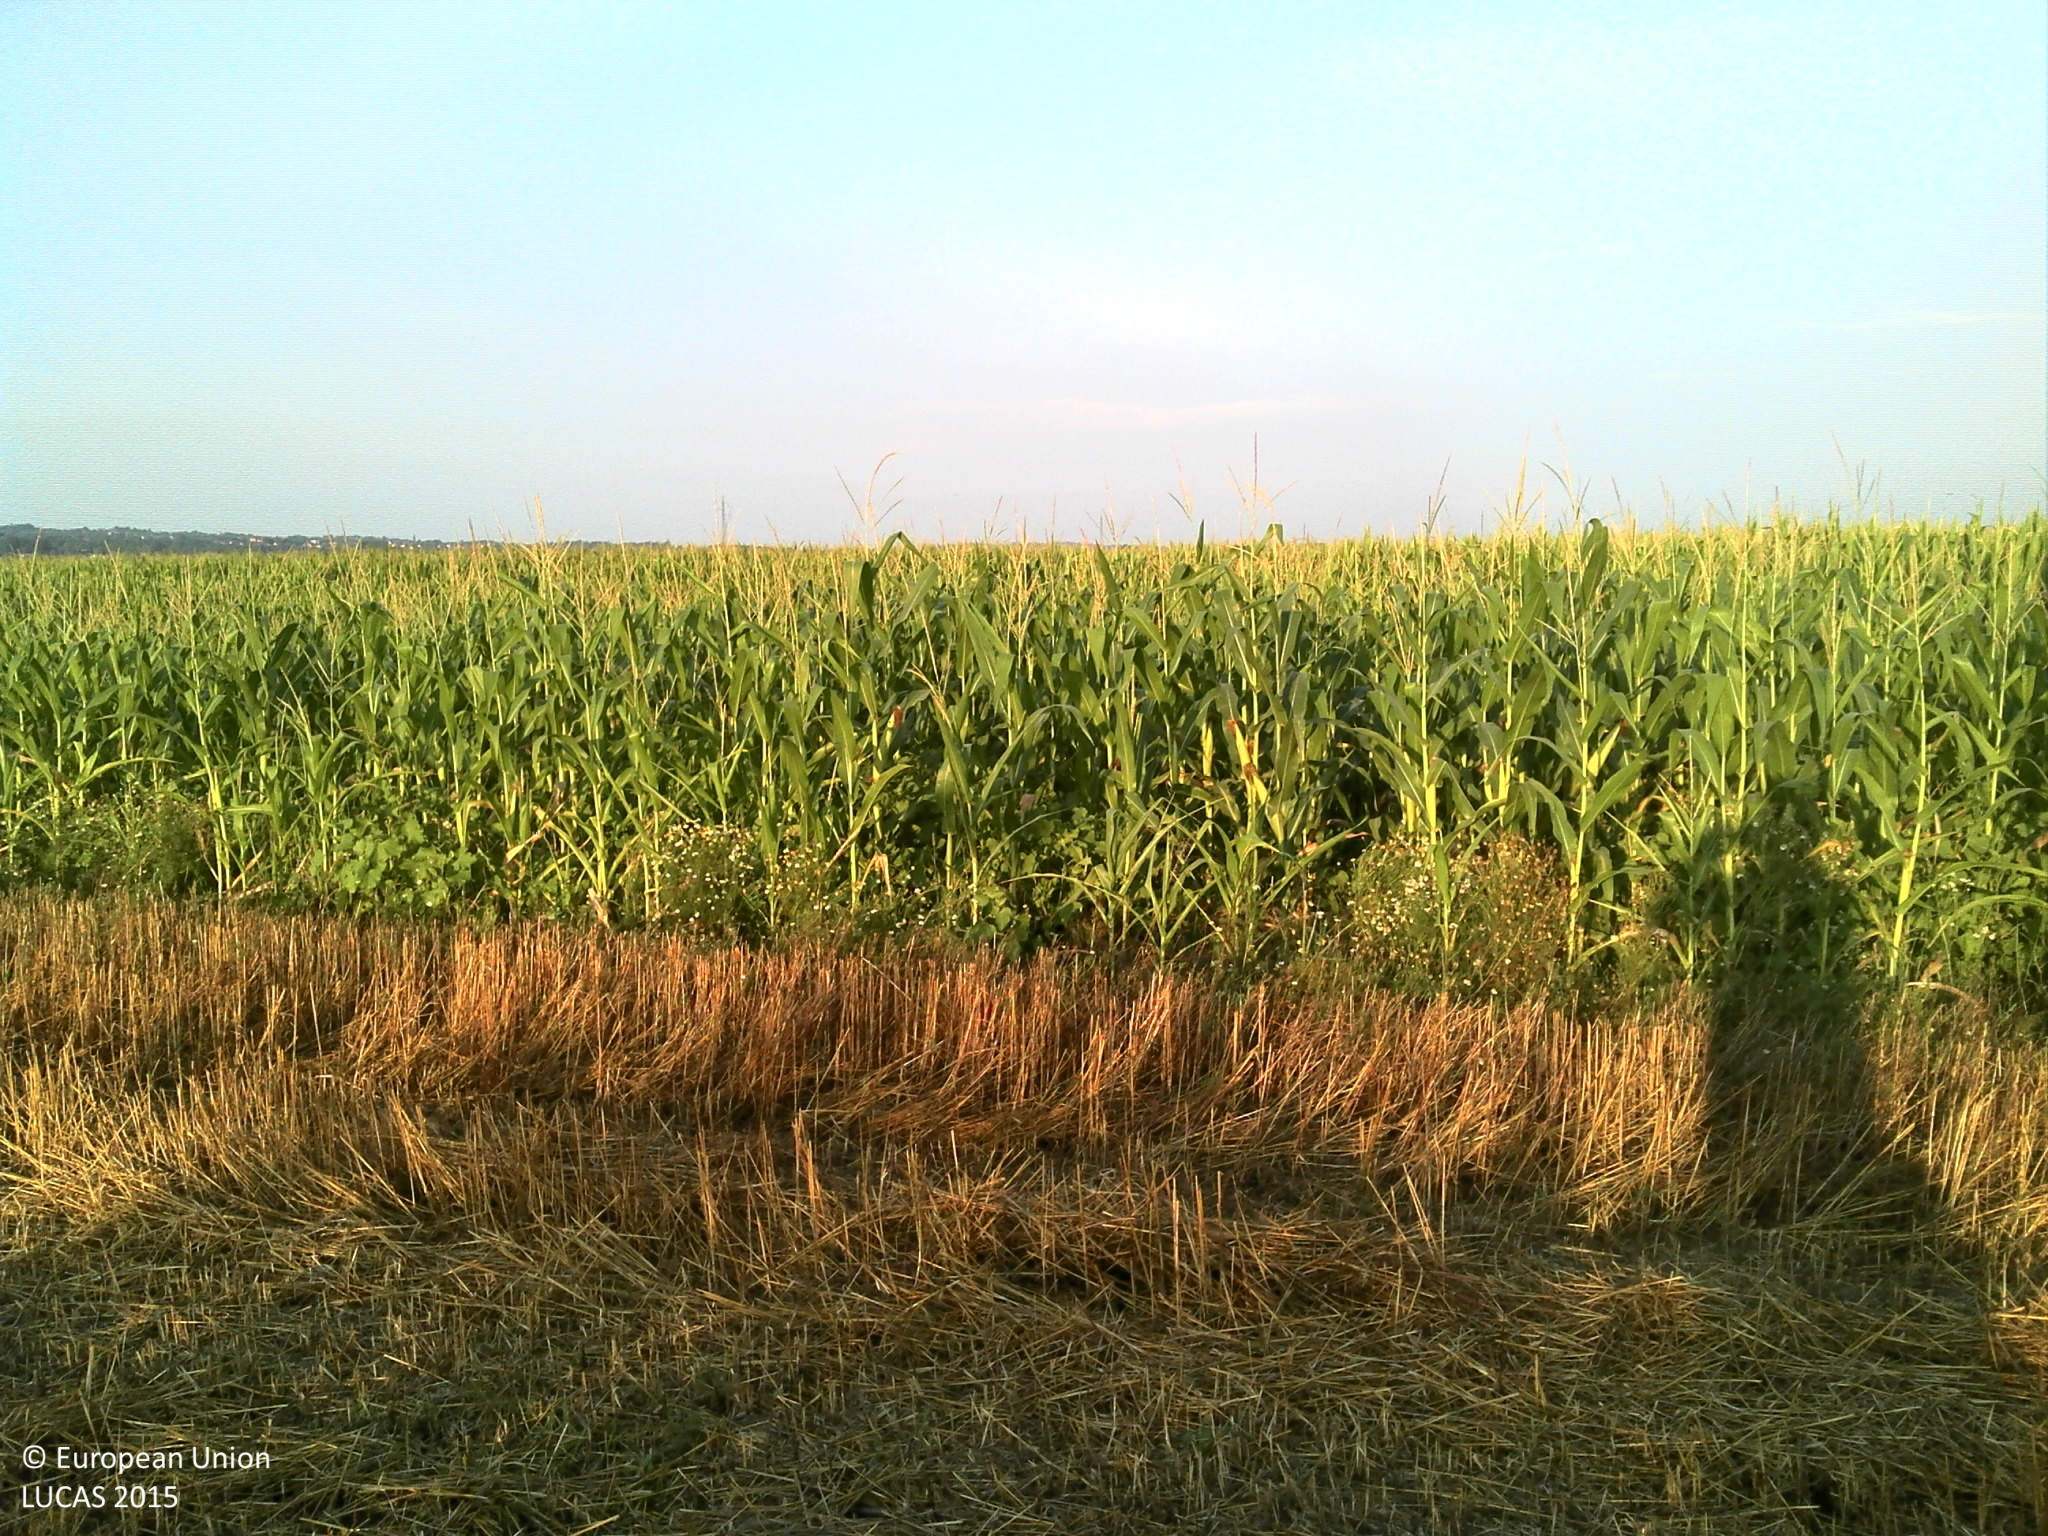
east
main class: Cropland
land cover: Barley
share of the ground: < 10 %
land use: Agriculture (excluding fallow land and kitchen gardens)
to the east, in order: Barley; Maize; Spontaneously vegetated surfaces; Ditches and canals; Maize
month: July
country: HR
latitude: 45.4909
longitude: 16.6908
